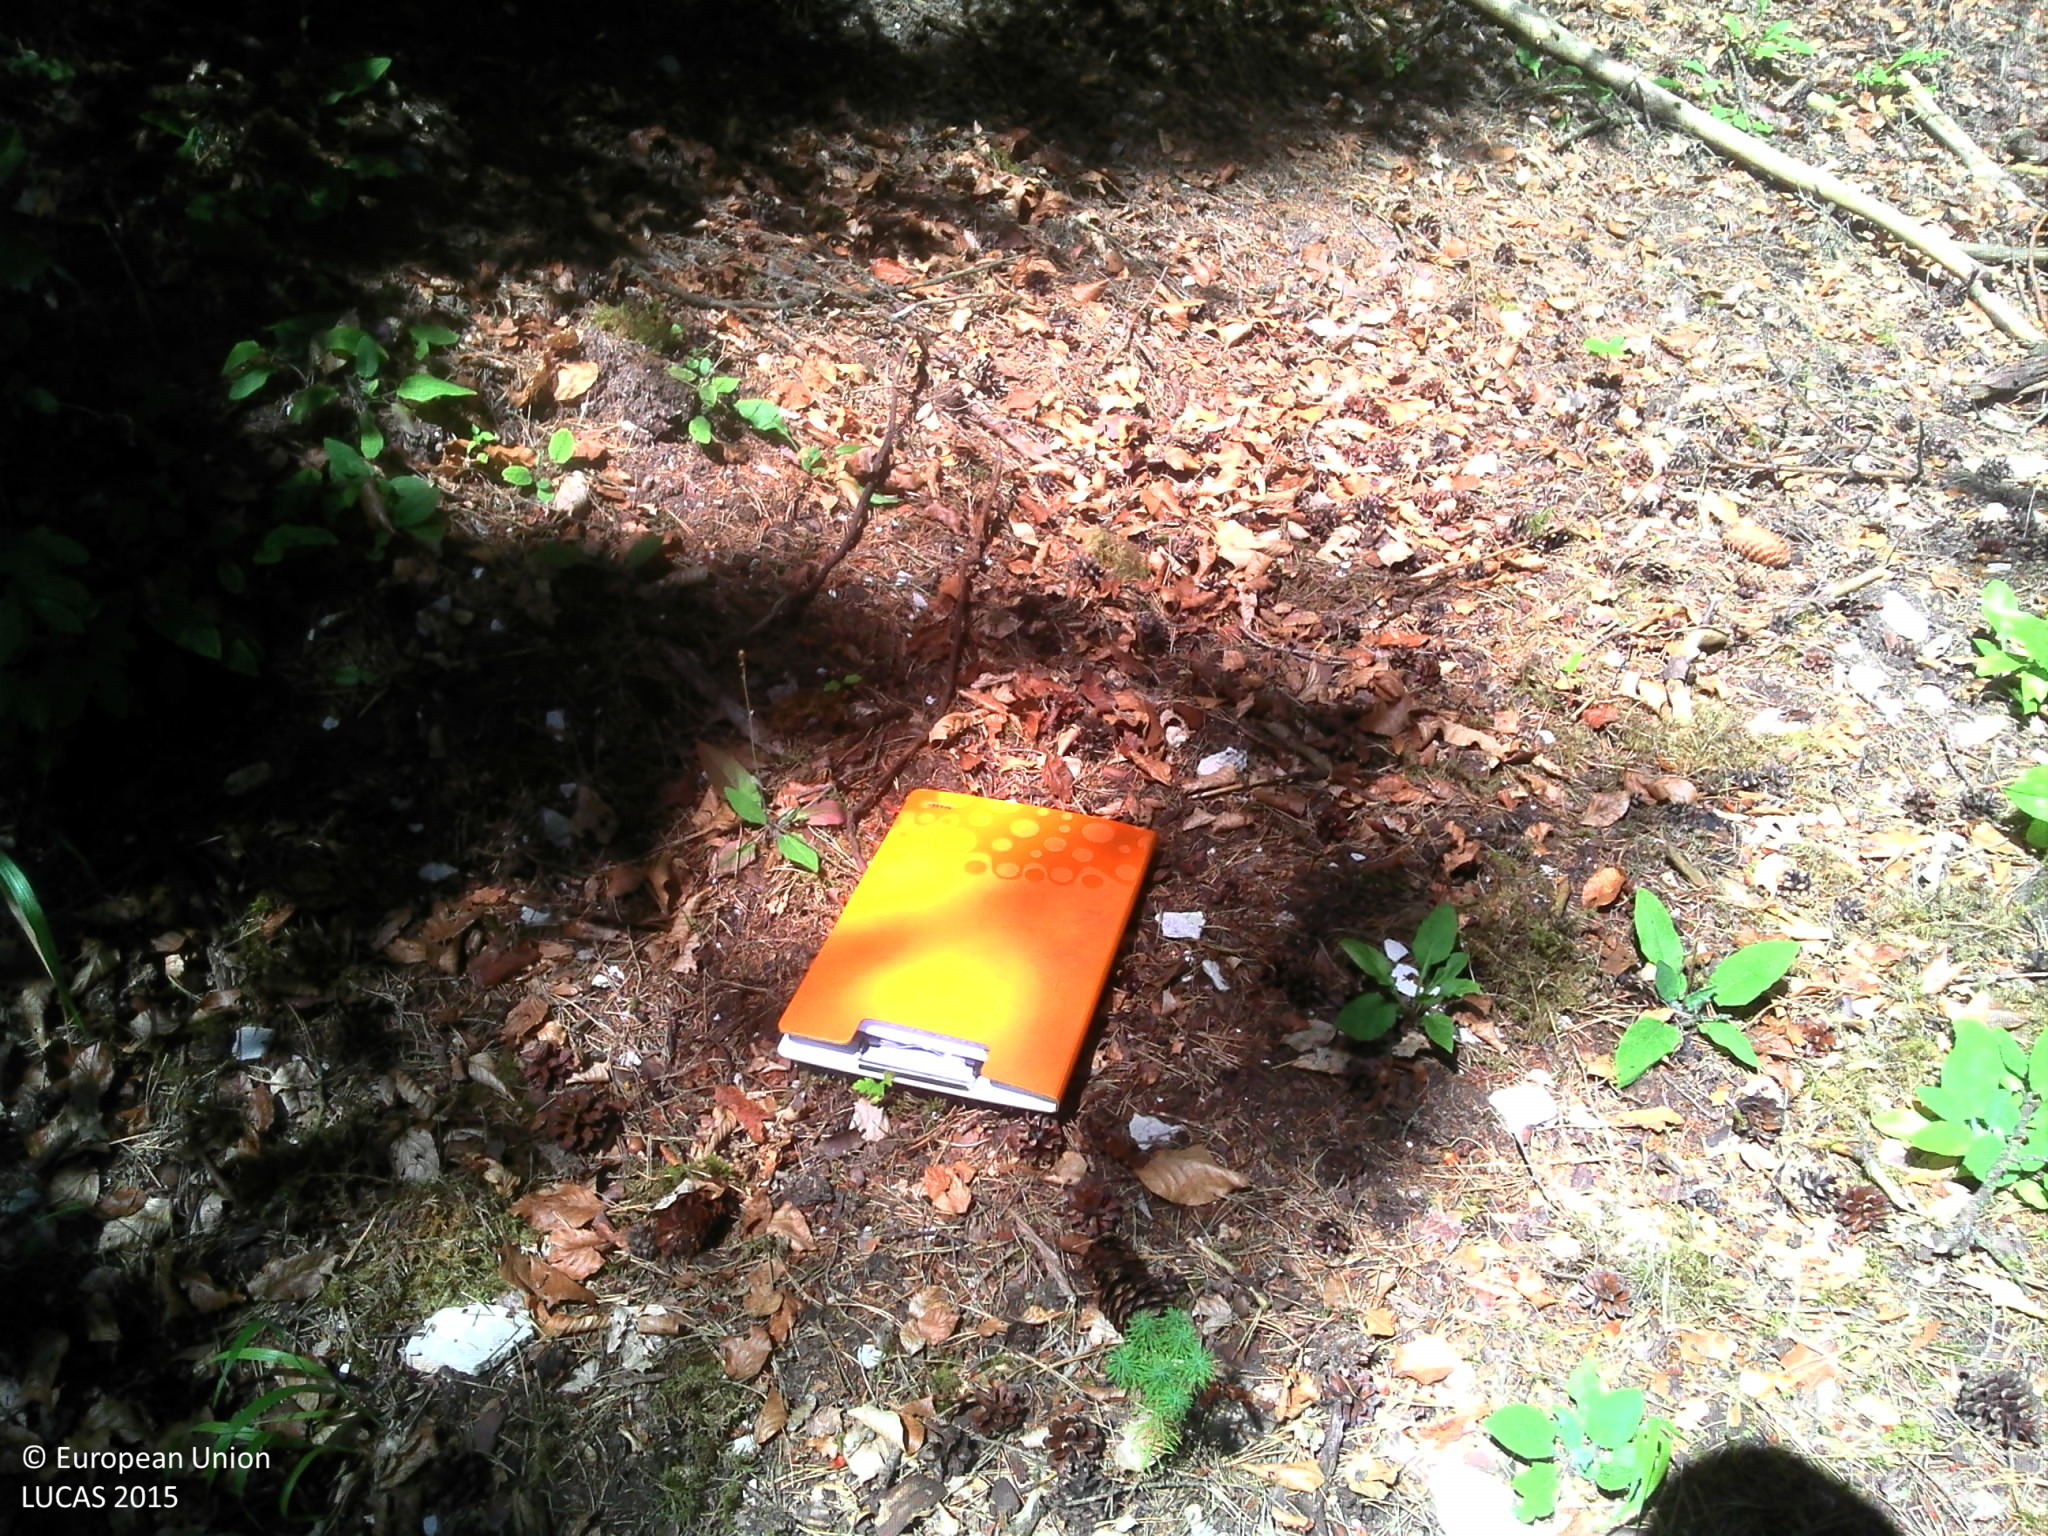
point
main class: Woodland
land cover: Spruce dominated coniferous woodland
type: hemiboreal forest and nemoral coniferous forest and mixed broadleaved-coniferous forest
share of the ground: > 75 %
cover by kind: coniferous forest trees 60 %, broadleaved forest trees 15 %, herbaceous plants 15 %, lichens and mosses 10 %
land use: Forestry
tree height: > 5 m
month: July
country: FR
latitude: 47.9350
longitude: 5.1137
